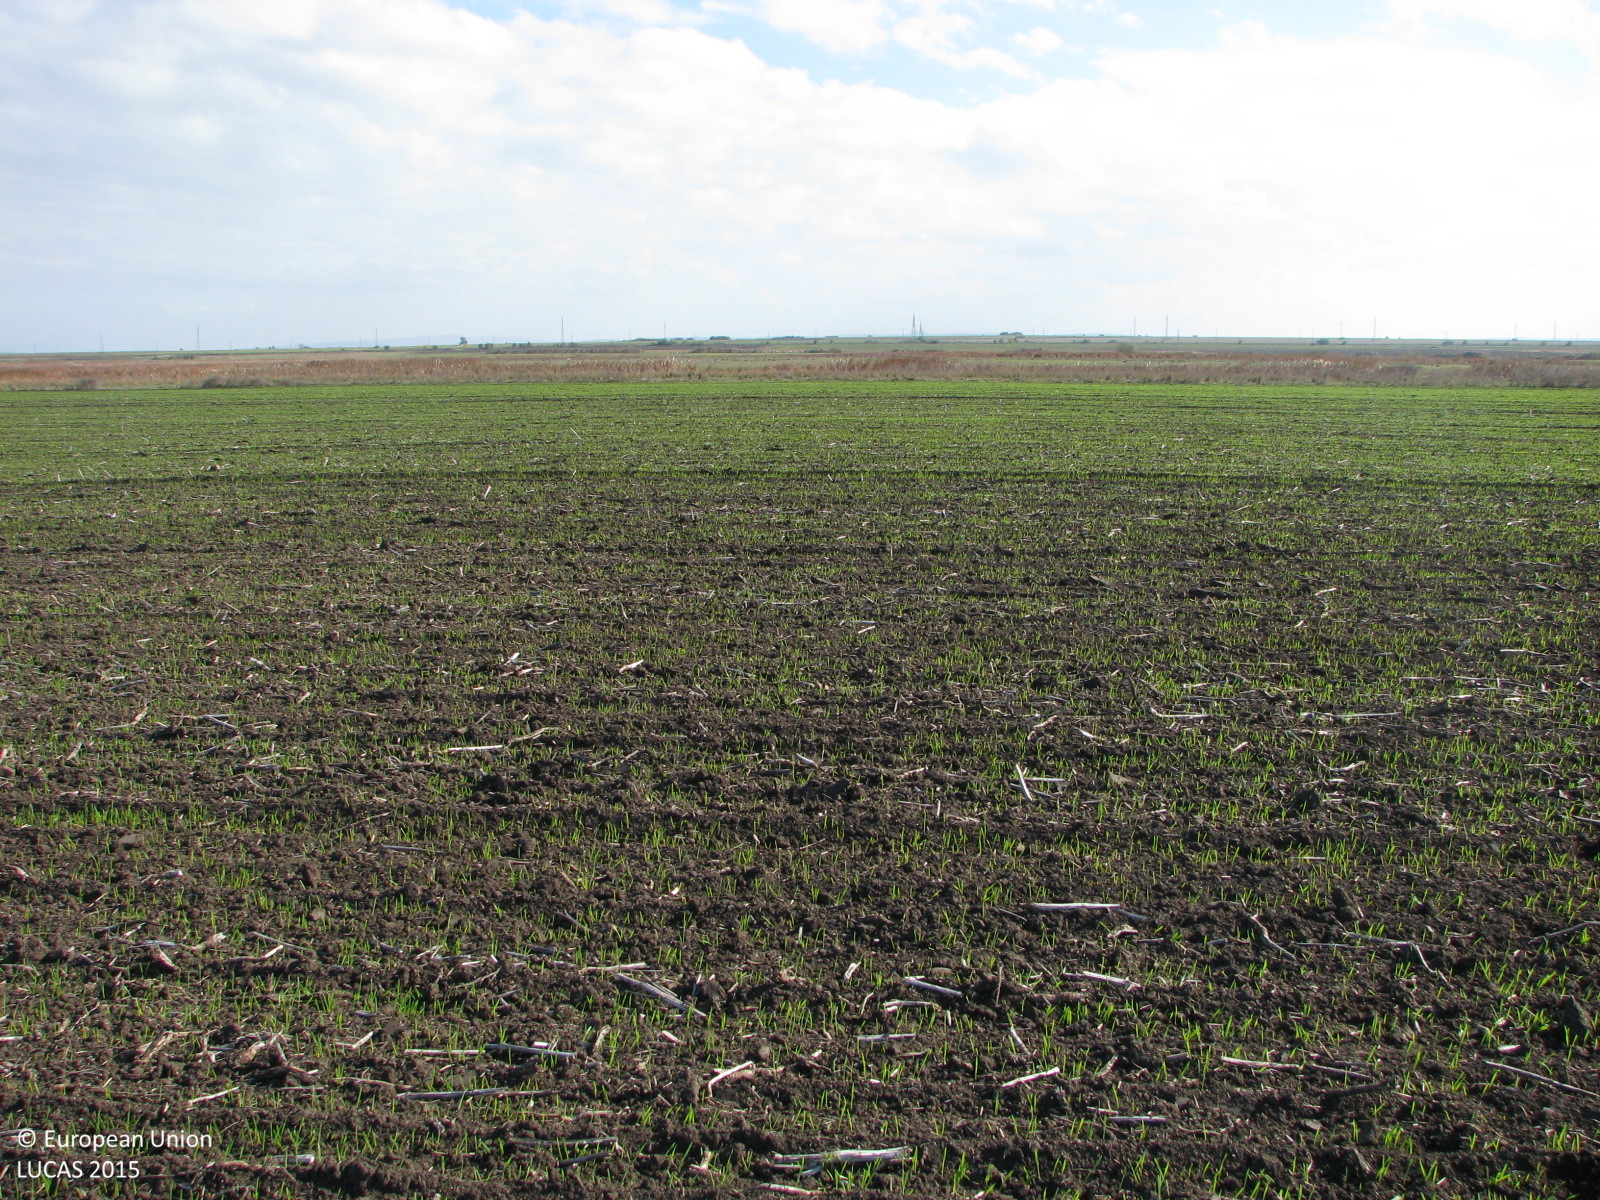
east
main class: Cropland
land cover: Common wheat
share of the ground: 10 - 25 %
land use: Agriculture (excluding fallow land and kitchen gardens)
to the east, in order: Common wheat; Tracks; Grassland without tree/shrub cover; Inland fresh running water; Grassland without tree/shrub cover
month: November
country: BG
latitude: 42.5664
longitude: 26.6764
